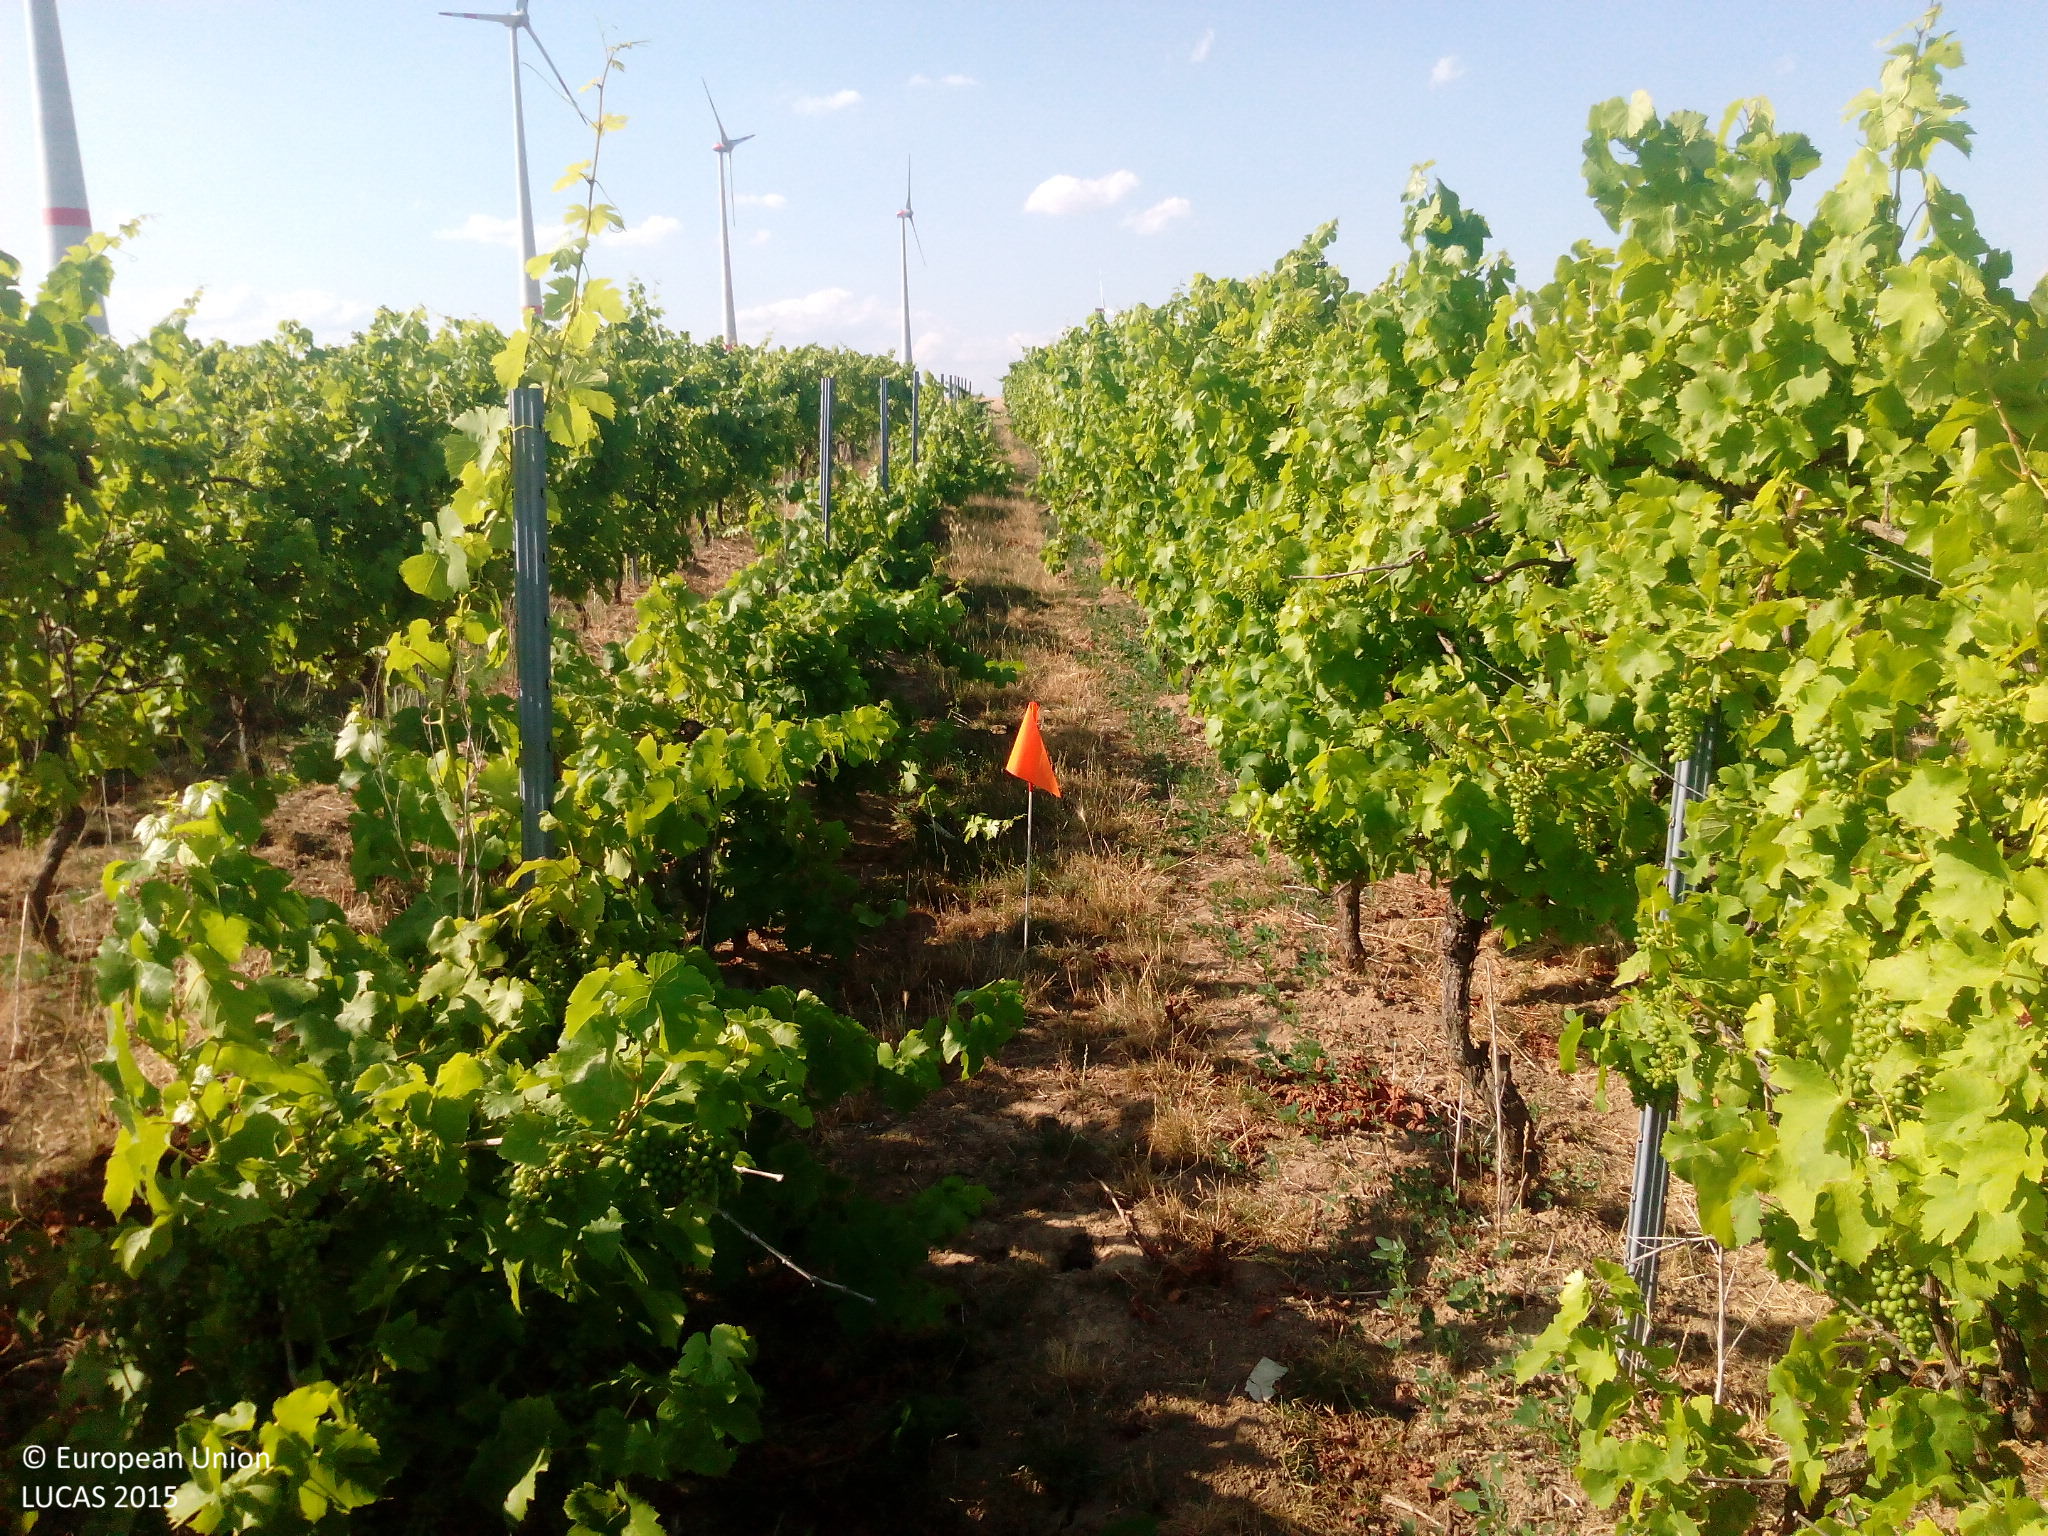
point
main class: Cropland
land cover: Vineyards
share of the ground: > 75 %
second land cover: Grassland without tree/shrub cover
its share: 50 - 75 %
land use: Agriculture (excluding fallow land and kitchen gardens)
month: July
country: DE
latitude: 49.8275
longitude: 8.1516
